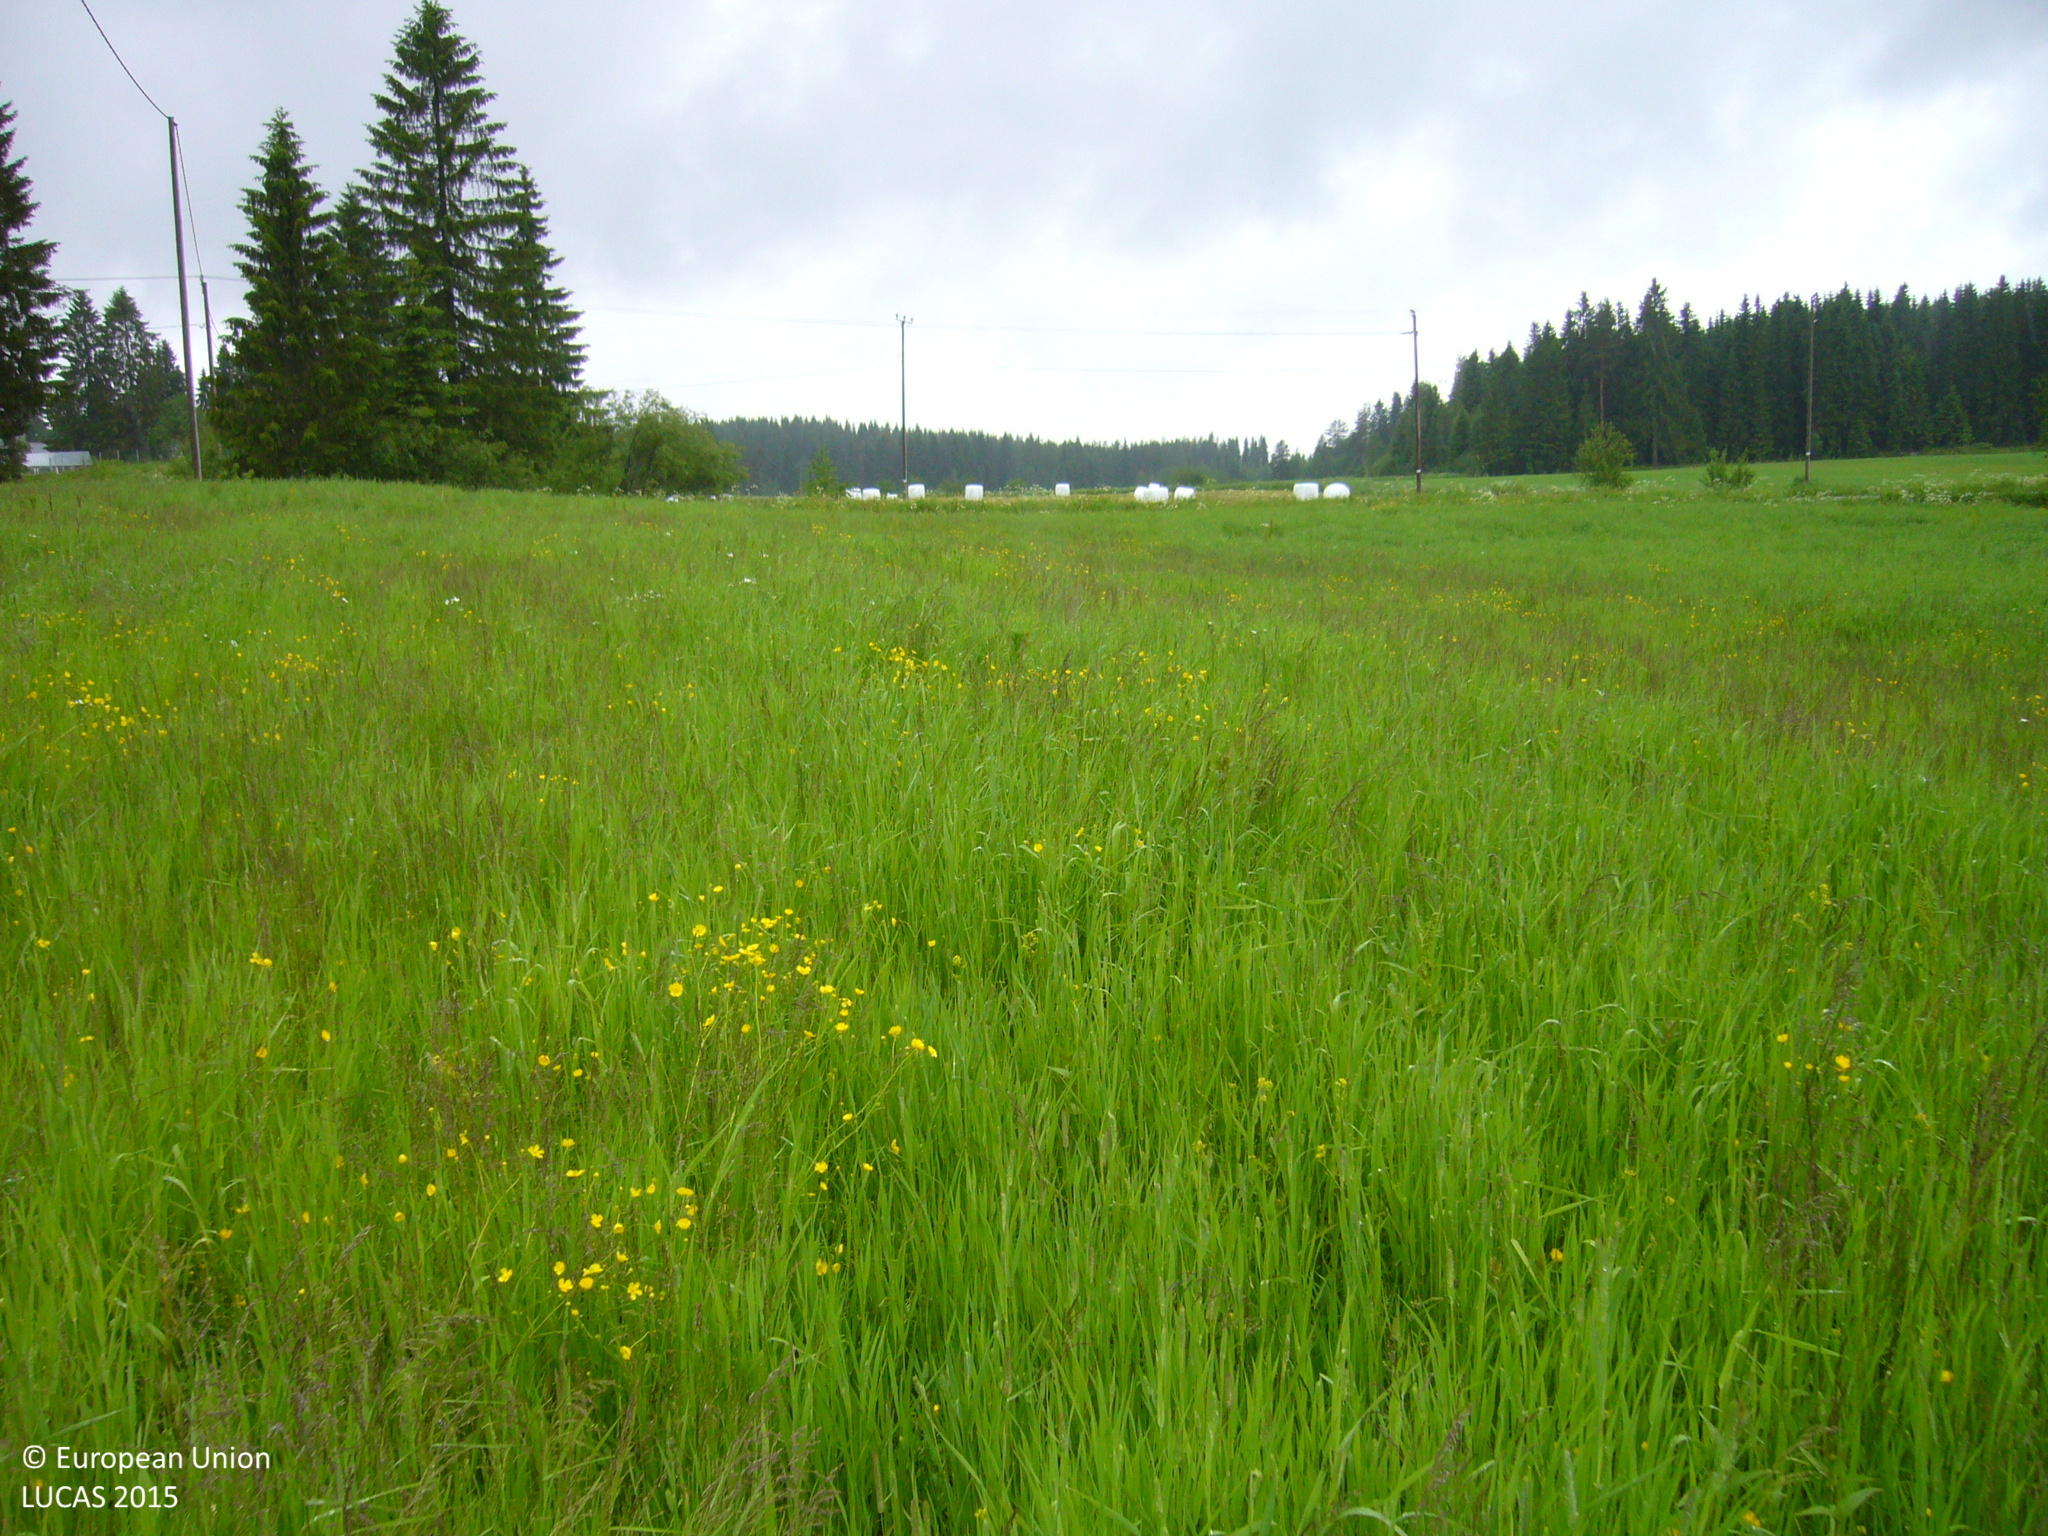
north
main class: Cropland
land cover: Temporary grasslands
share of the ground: > 75 %
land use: Agriculture (excluding fallow land and kitchen gardens)
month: June
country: FI
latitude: 63.6877
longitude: 26.1917
